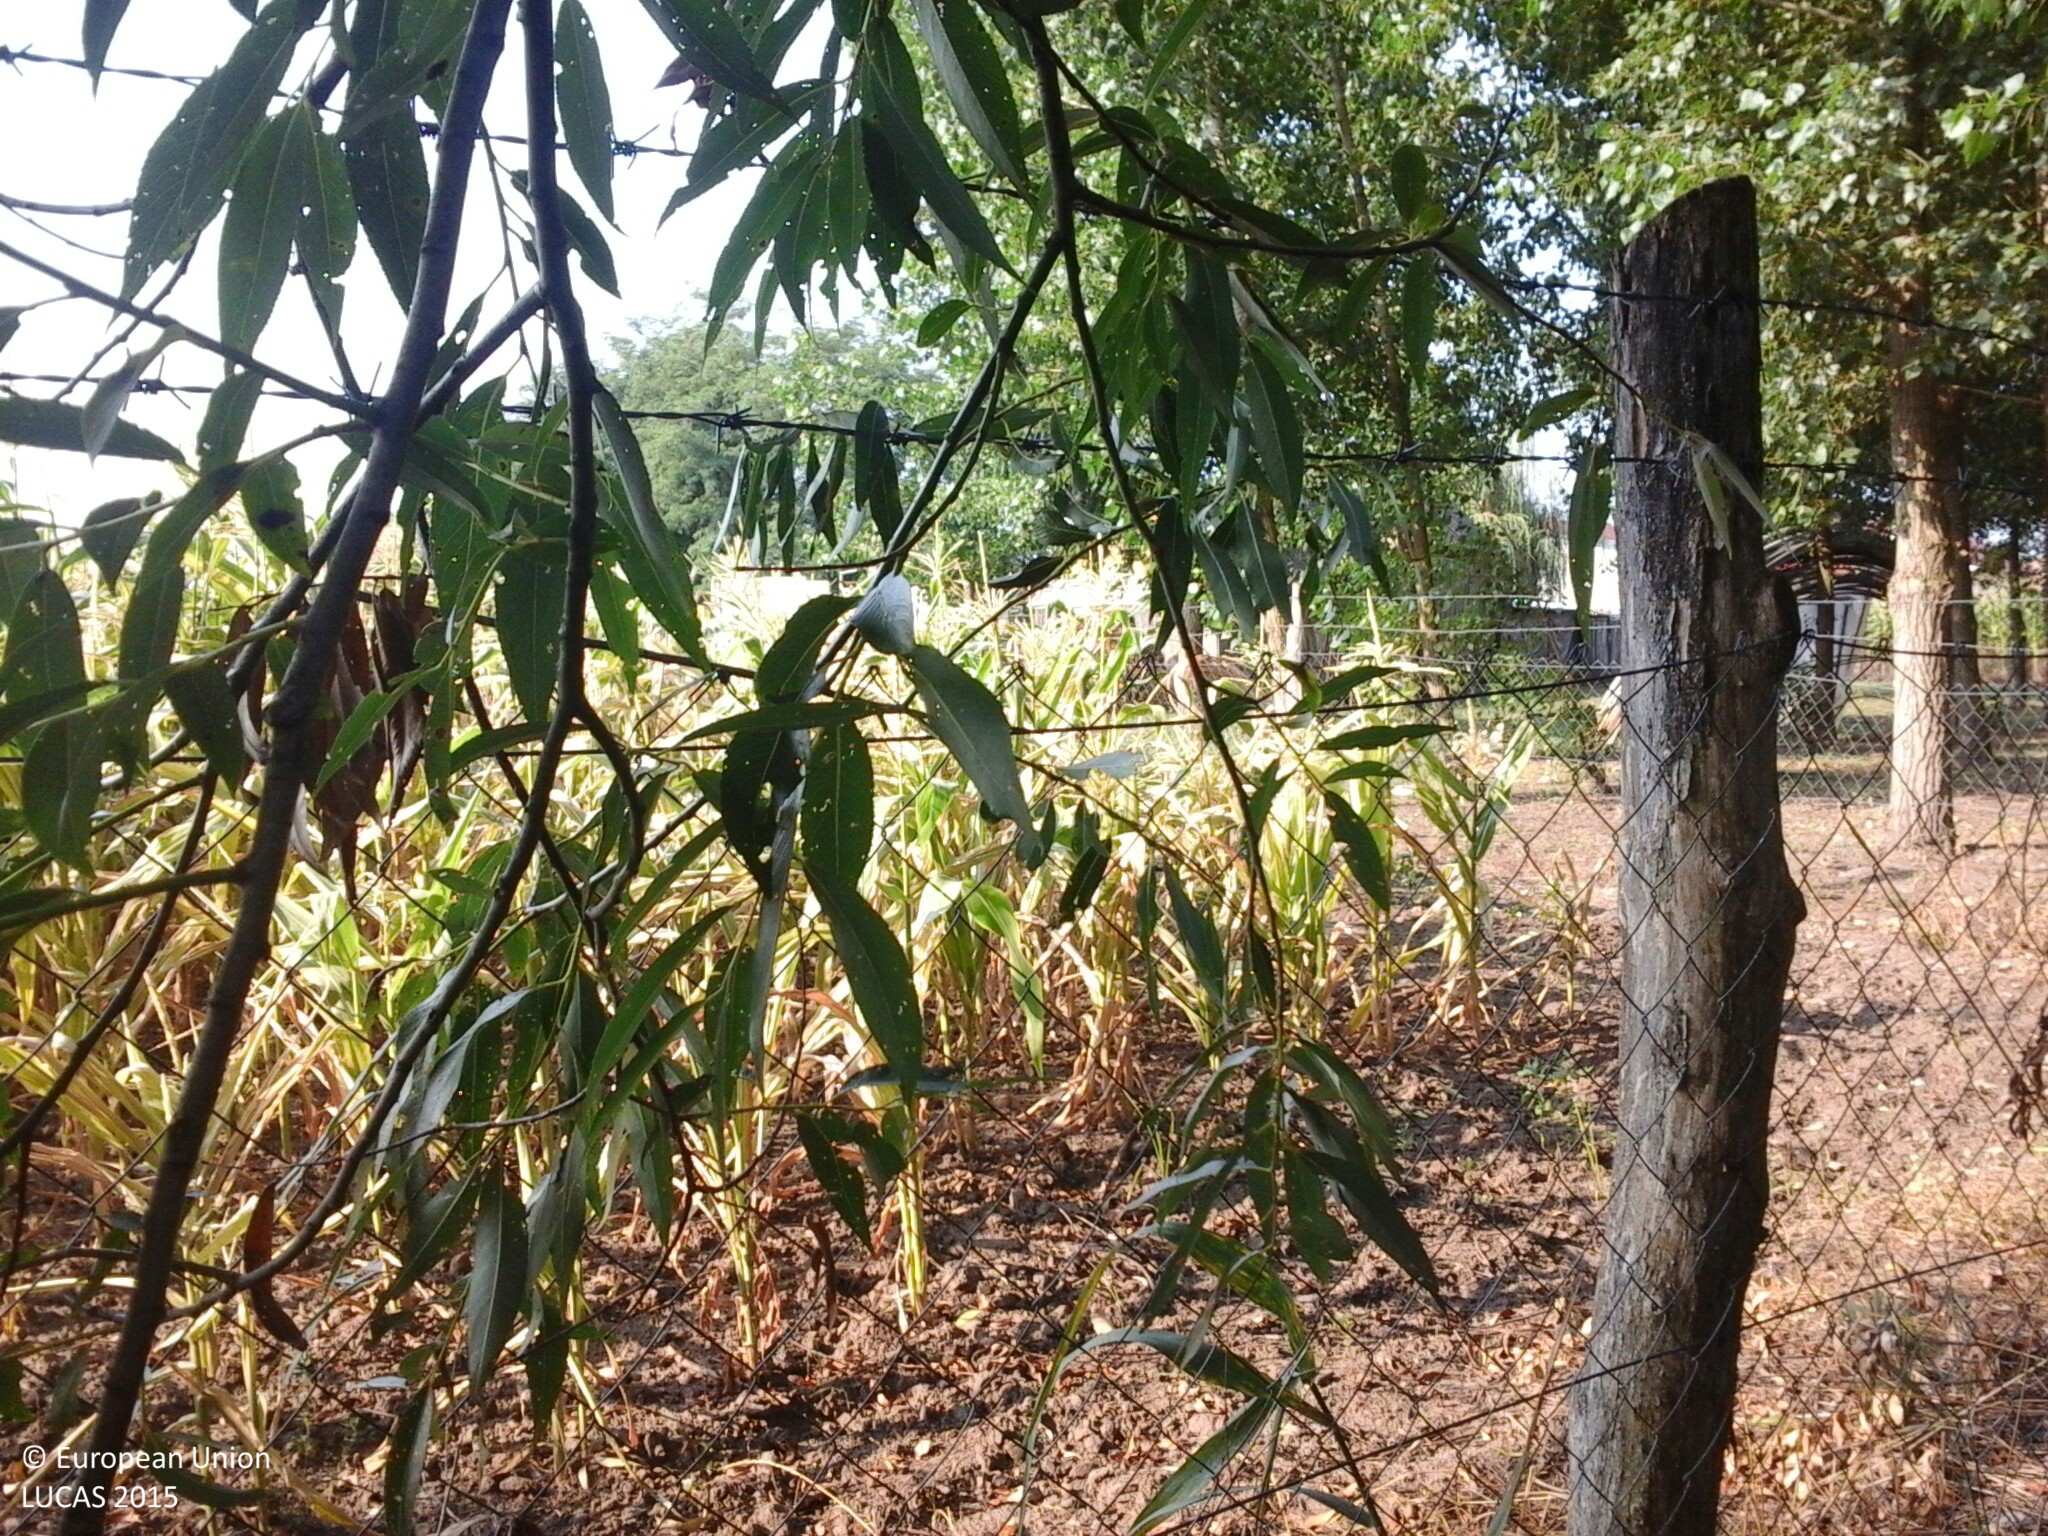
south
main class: Woodland
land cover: Broadleaved woodland
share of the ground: > 75 %
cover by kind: broadleaved forest trees 95 %, herbaceous plants 5 %
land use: Forestry
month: July
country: HU
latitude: 47.9729
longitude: 21.9328
